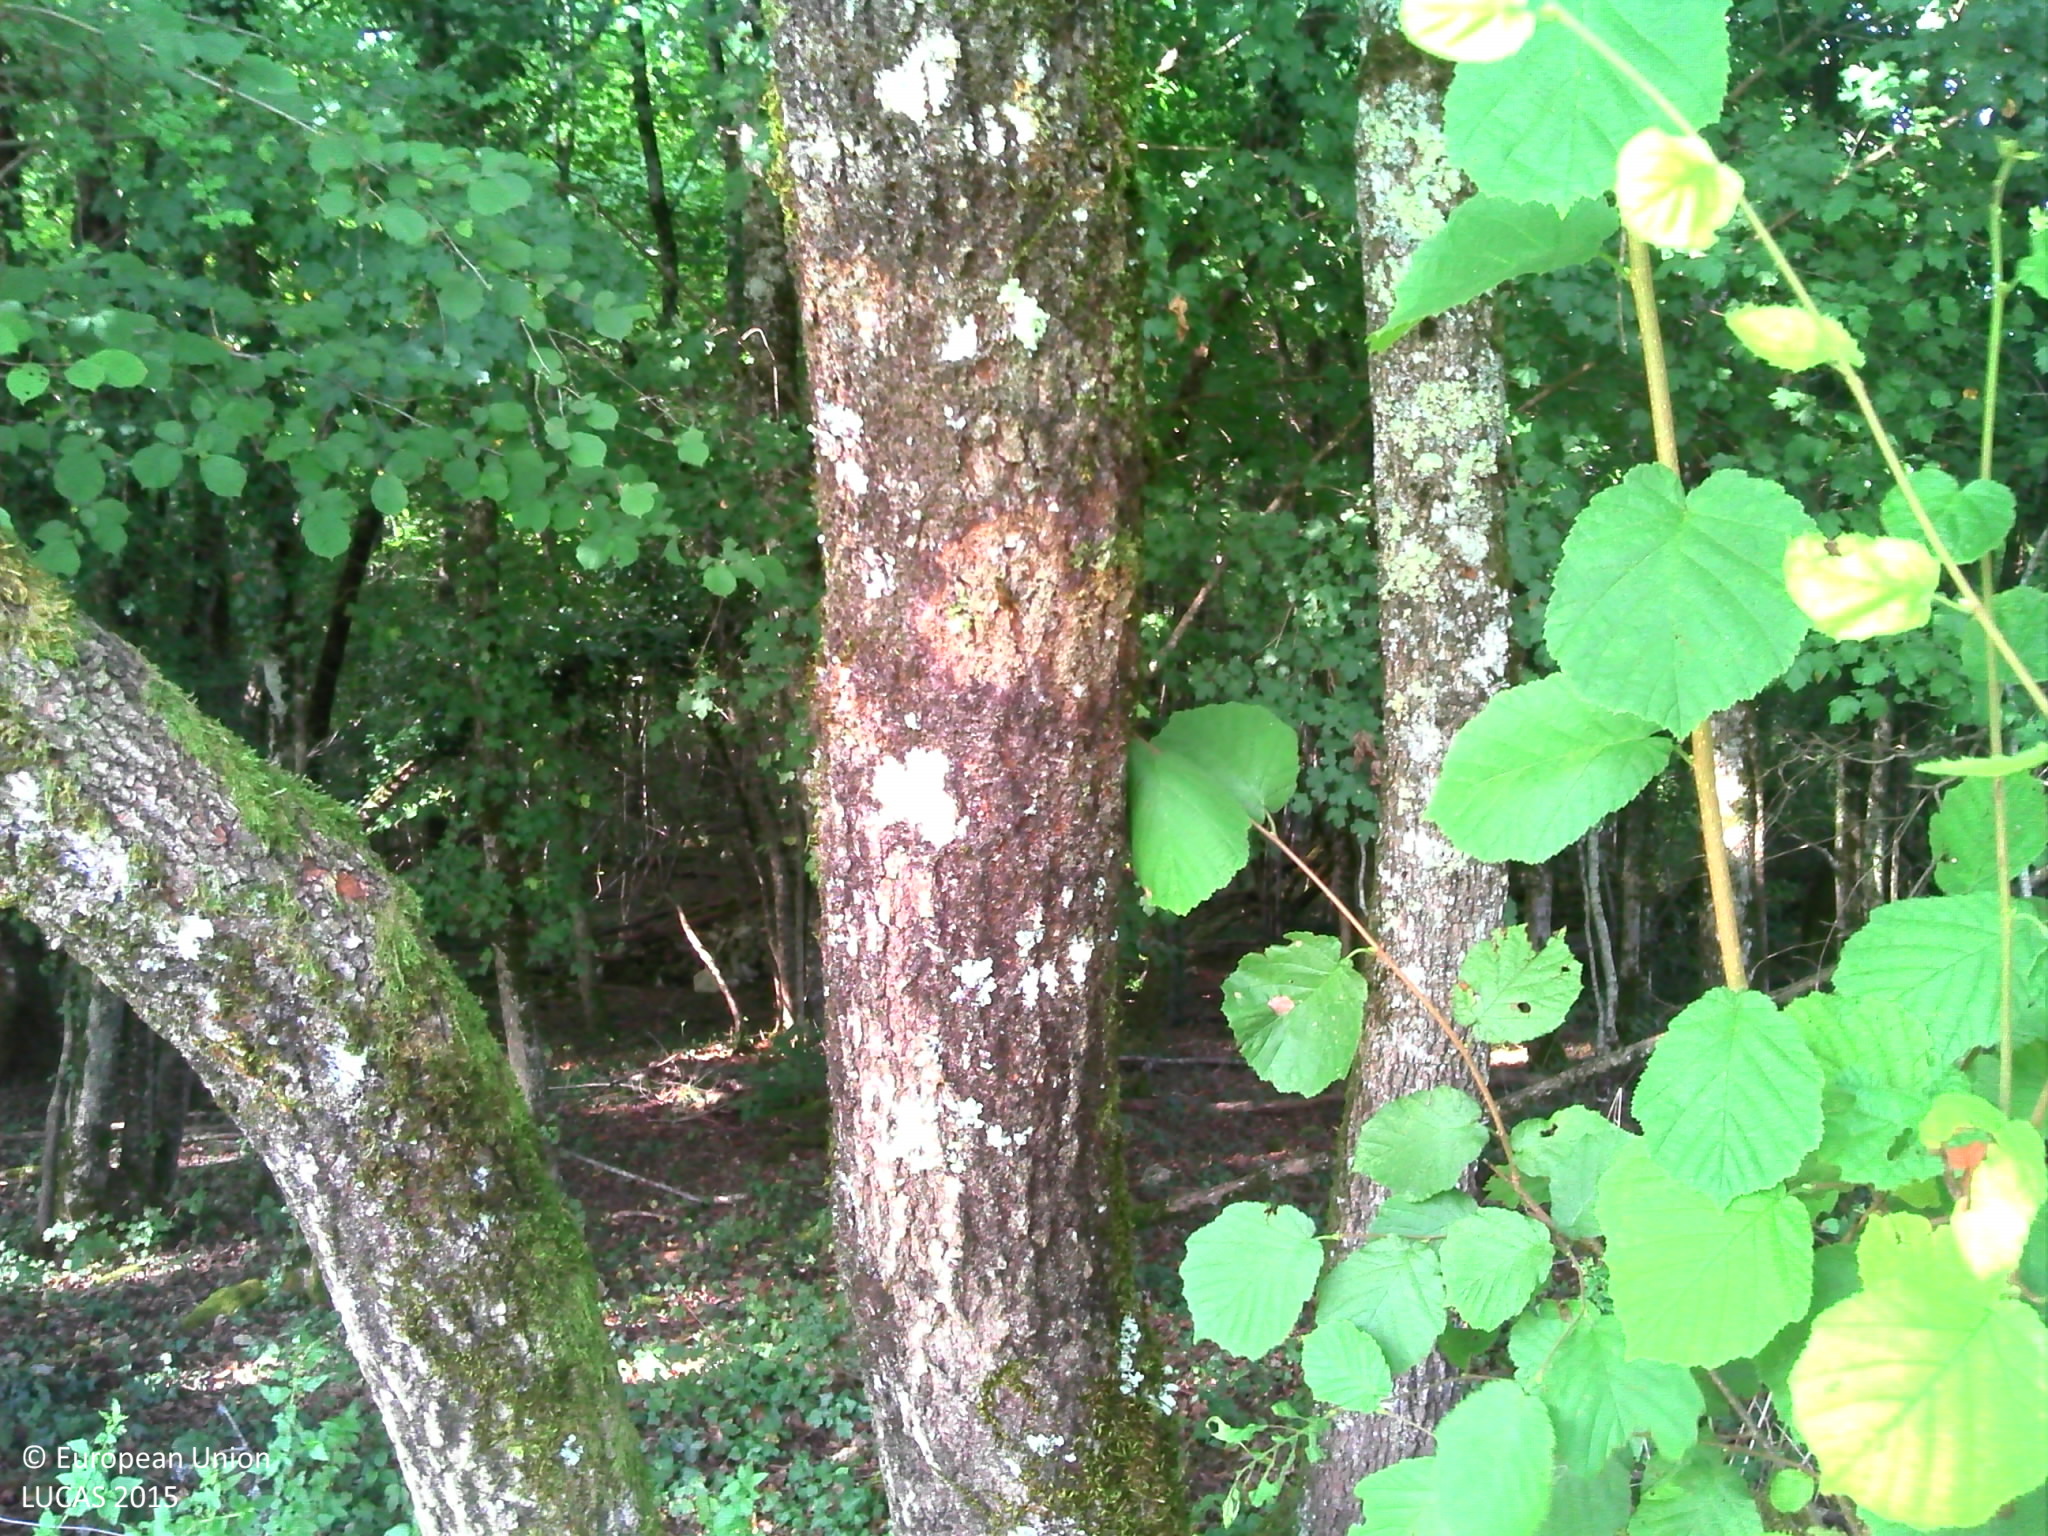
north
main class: Woodland
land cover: Broadleaved woodland
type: mesophytic deciduous forest
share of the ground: > 75 %
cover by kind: broadleaved forest trees 60 %, herbaceous plants 20 %, shrubs 10 %, lichens and mosses 10 %
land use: Forestry
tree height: > 5 m
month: August
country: FR
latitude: 45.4191
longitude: 0.4923
